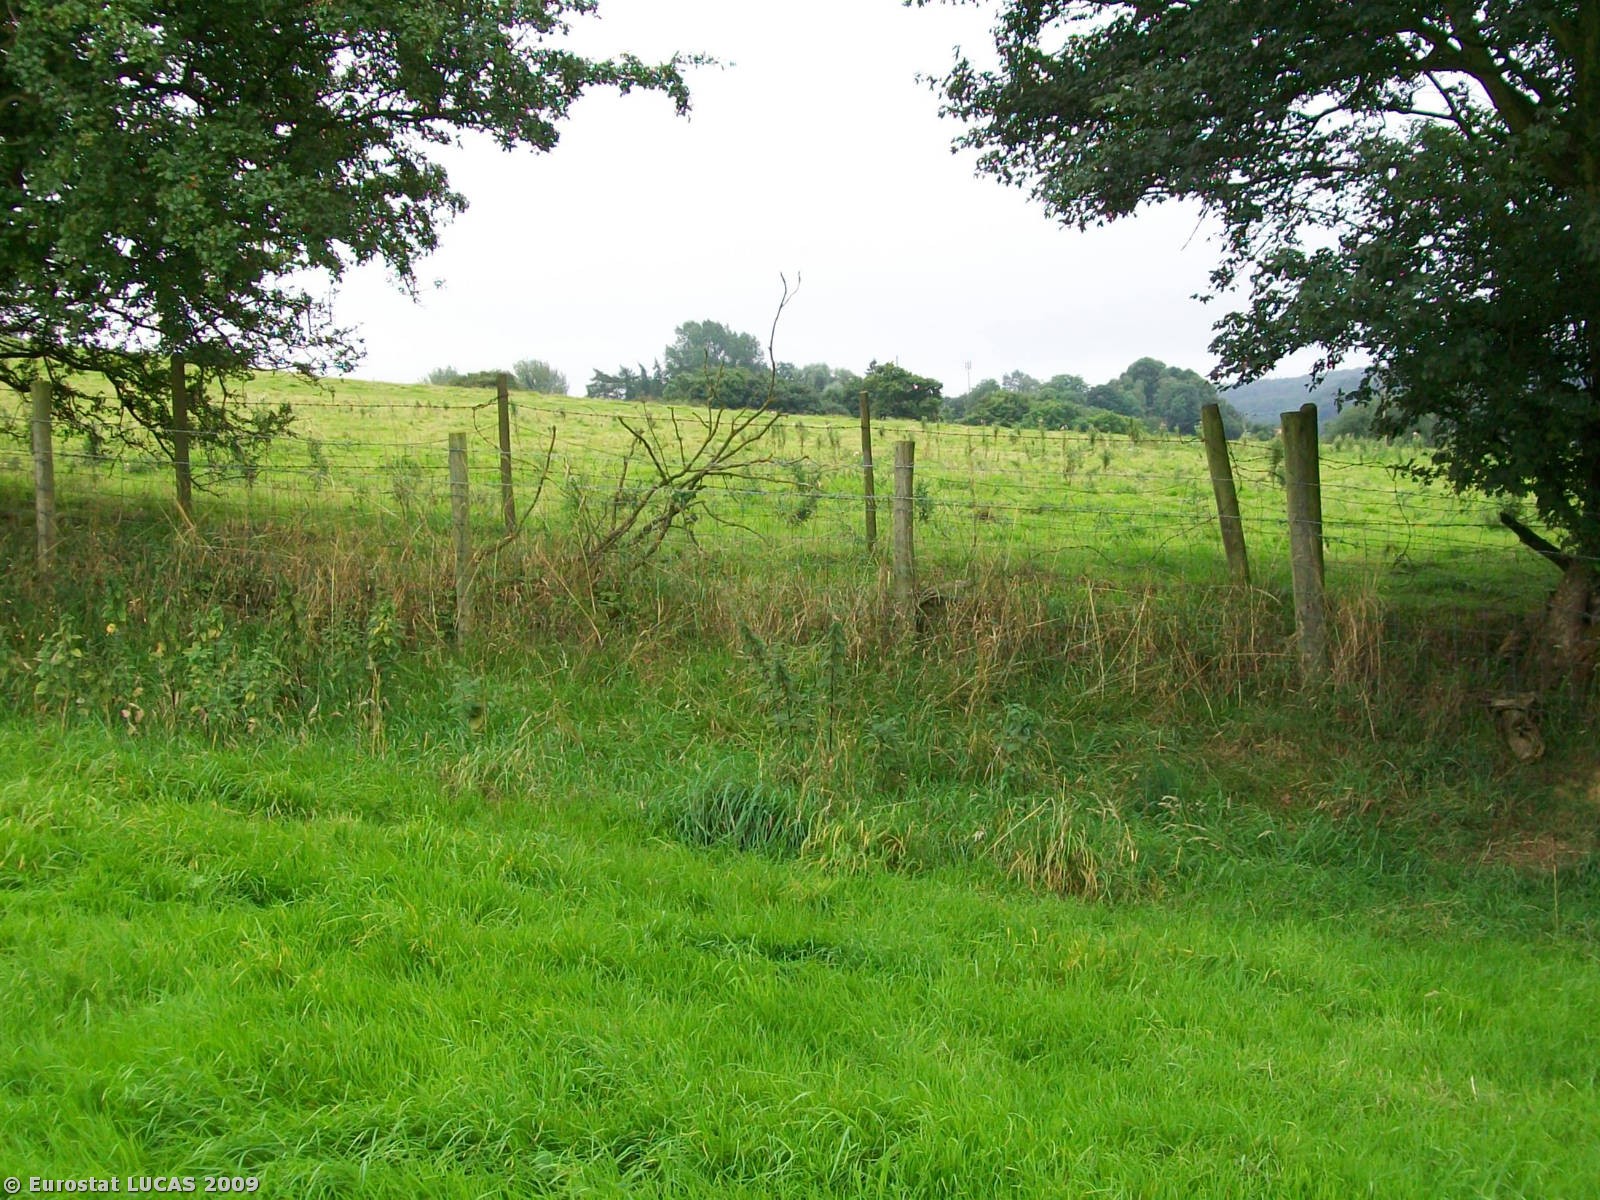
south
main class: Grassland
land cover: Grassland without tree/shrub cover
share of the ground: > 75 %
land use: Agriculture (excluding fallow land and kitchen gardens)
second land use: Community services
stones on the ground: < 10 %
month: August
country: GB
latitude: 51.6935
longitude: -2.3464
